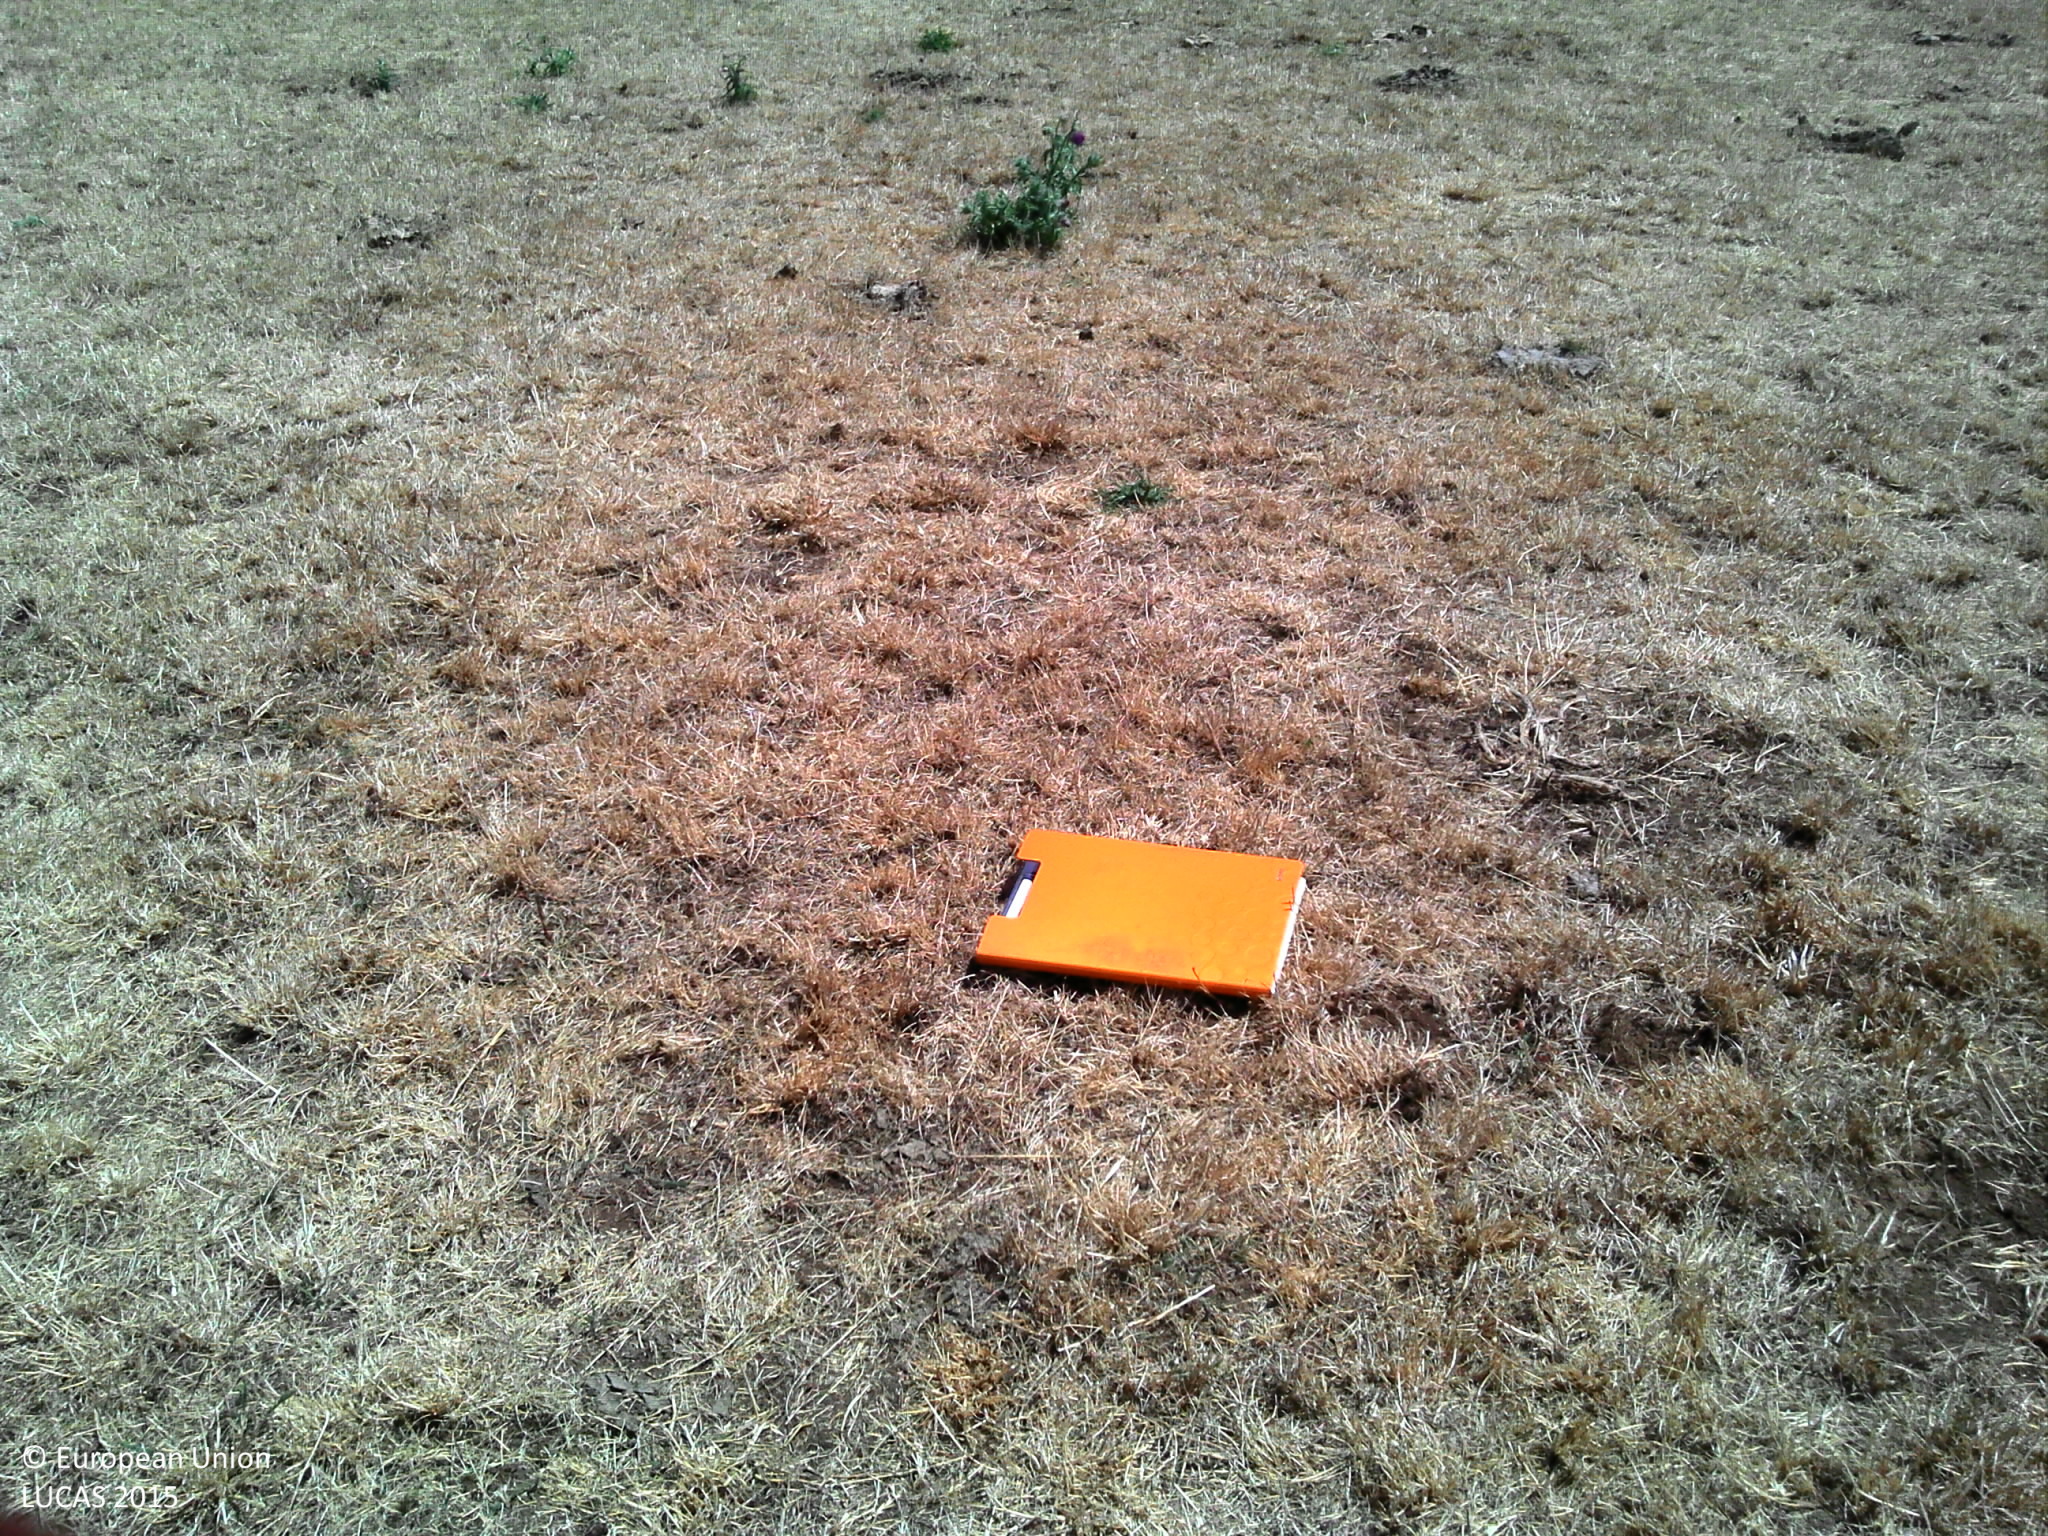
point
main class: Grassland
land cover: Grassland without tree/shrub cover
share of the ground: > 75 %
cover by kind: herbaceous plants 100 %
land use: Agriculture (excluding fallow land and kitchen gardens)
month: July
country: FR
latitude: 47.8428
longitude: 5.0689
